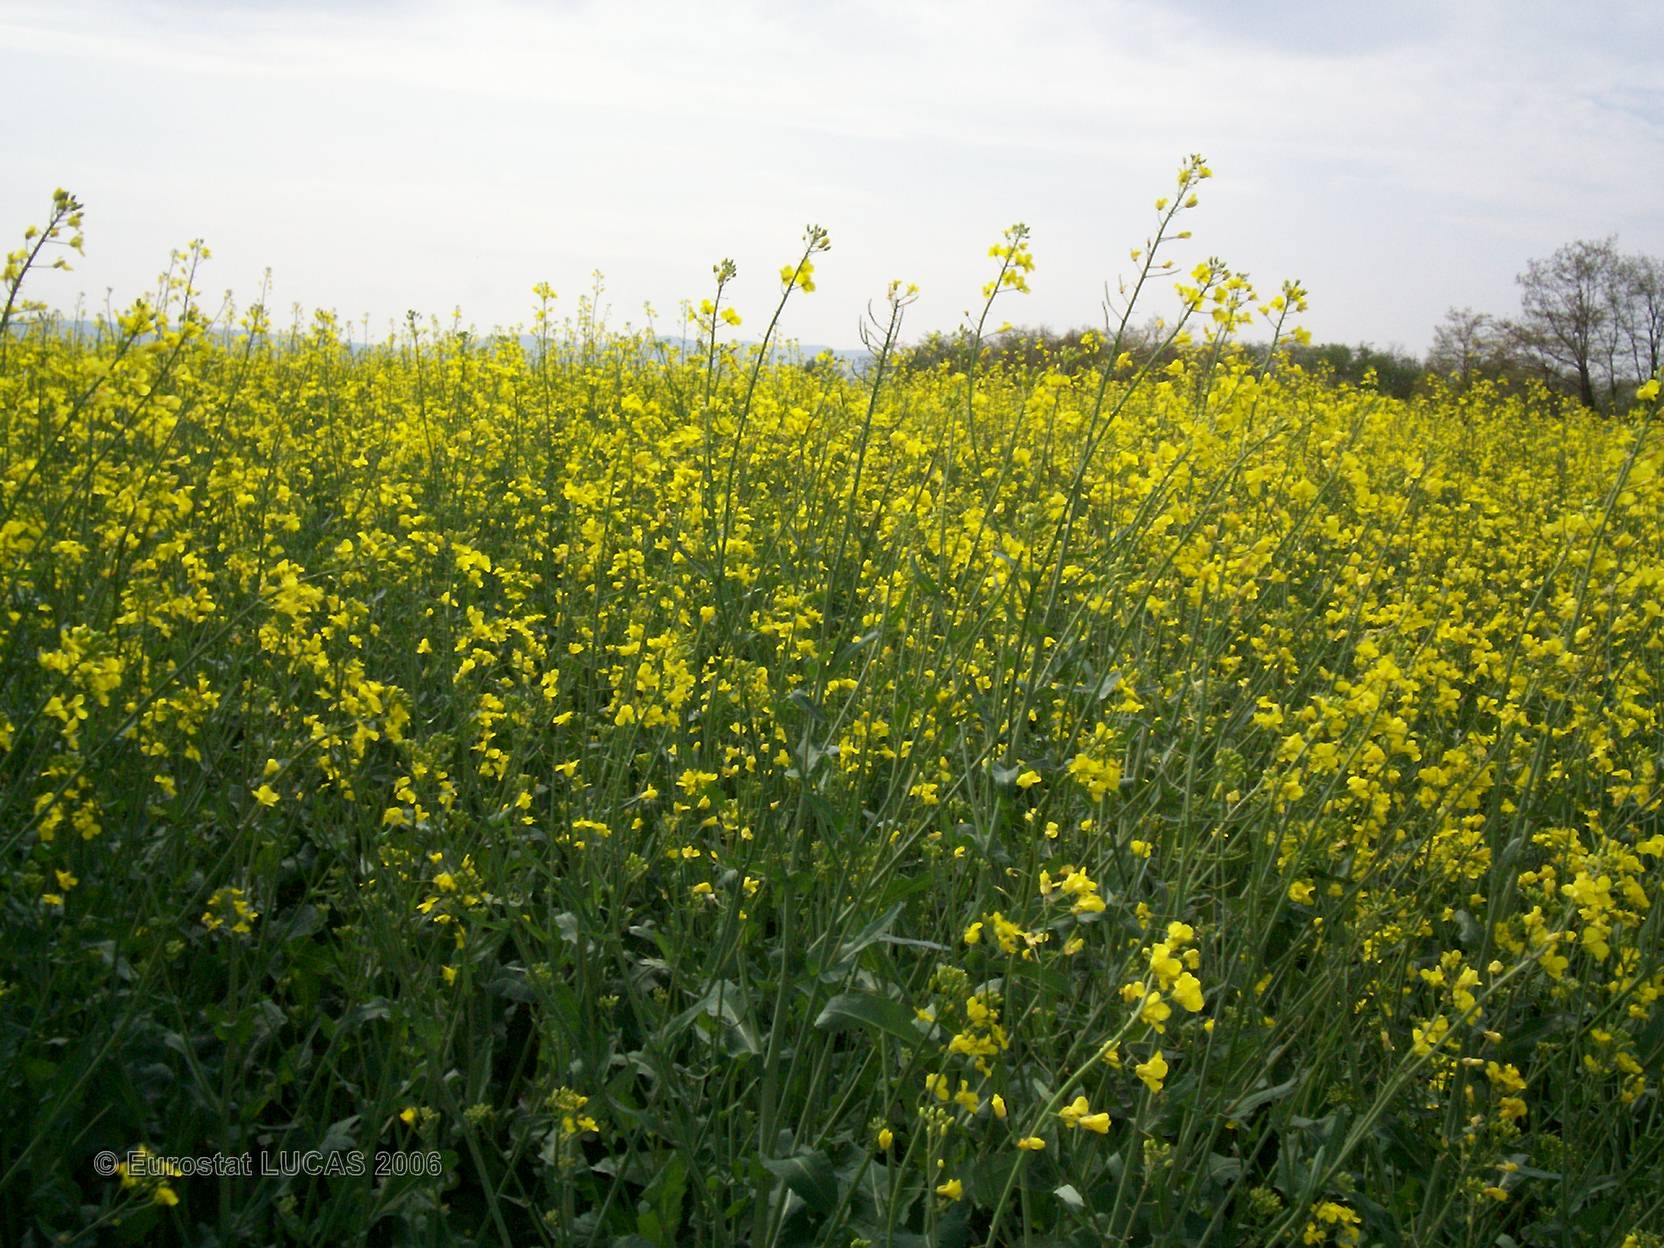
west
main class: Cropland
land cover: Oats
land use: Agriculture (excluding fallow land and kitchen gardens)
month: May
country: FR
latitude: 46.0068
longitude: 4.7727
